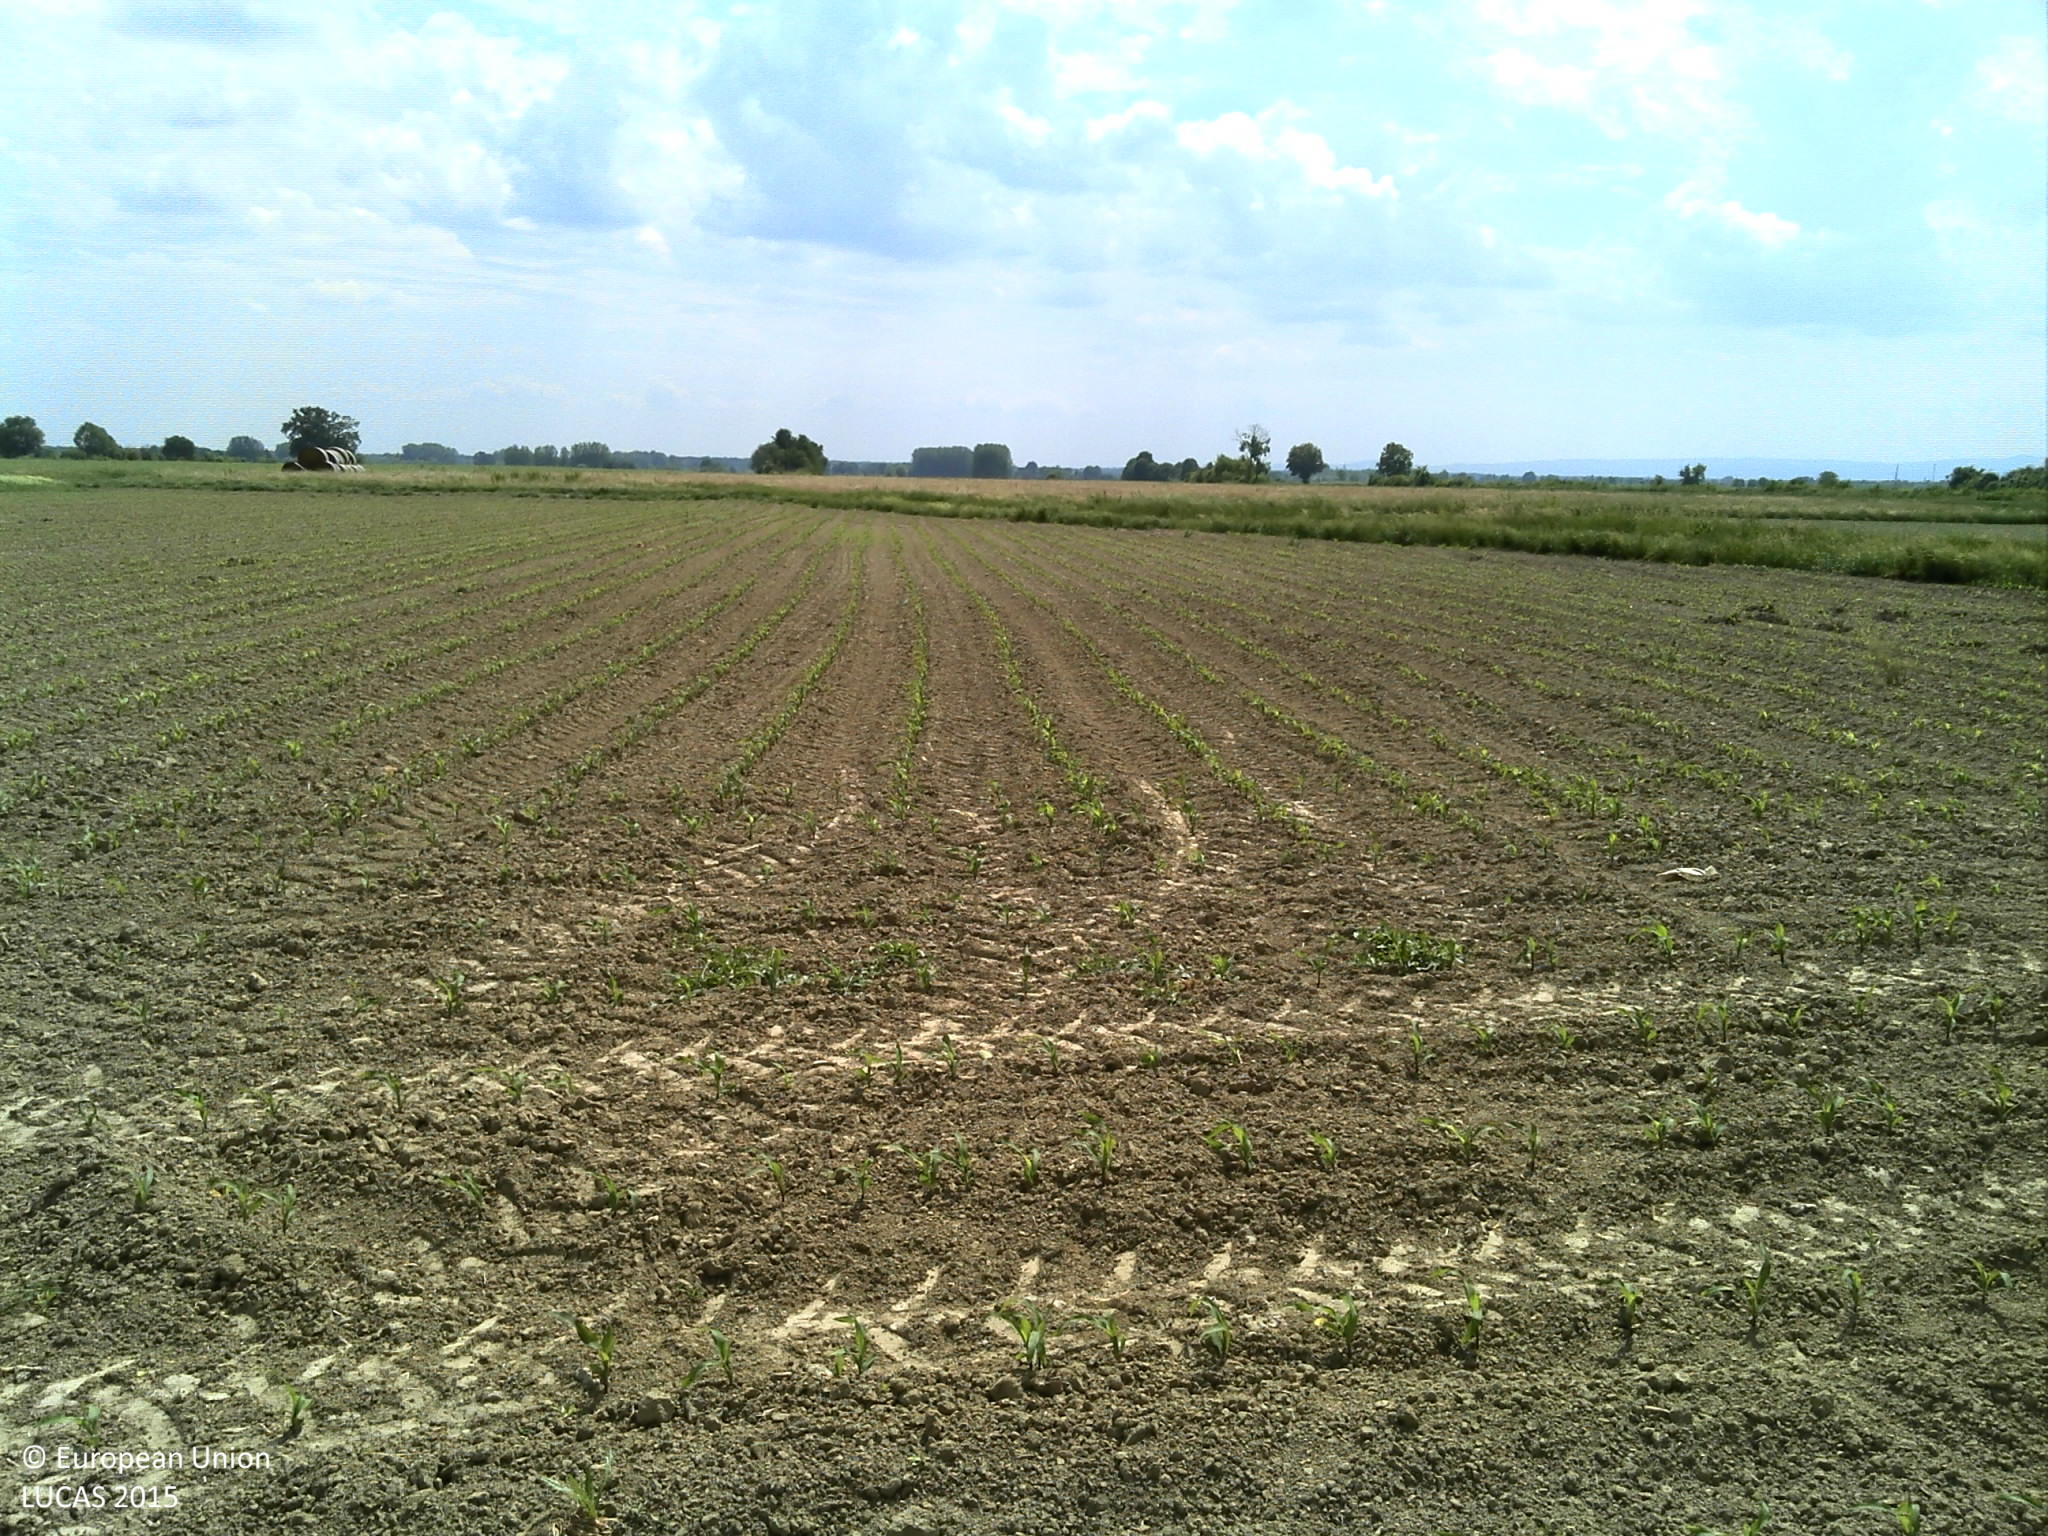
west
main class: Grassland
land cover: Spontaneously vegetated surfaces
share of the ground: > 75 %
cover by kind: herbaceous plants 100 %
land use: Semi-natural and natural areas not in use
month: May
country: HR
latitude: 45.6554
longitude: 18.2057
